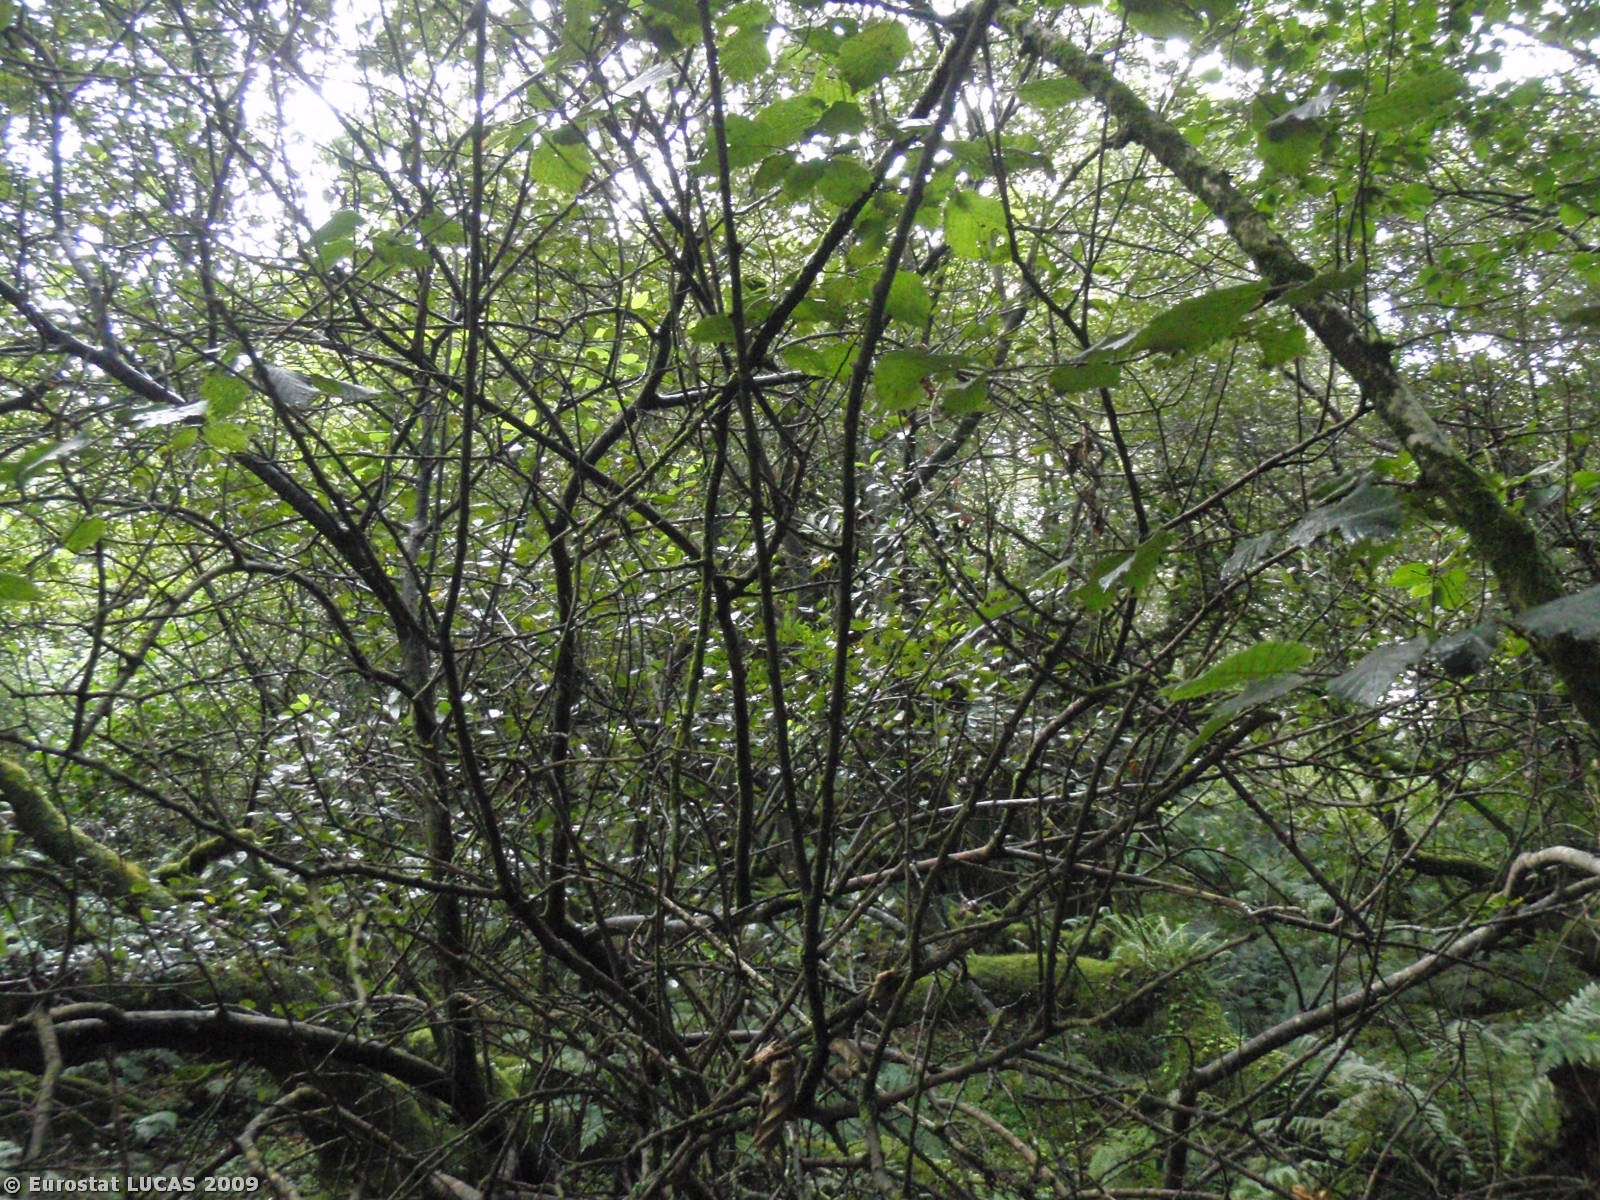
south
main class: Woodland
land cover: Broadleaved woodland
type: floodplain forest
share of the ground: > 75 %
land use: Unused
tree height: > 5 m
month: August
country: GB
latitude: 50.9265
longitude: -4.4011
